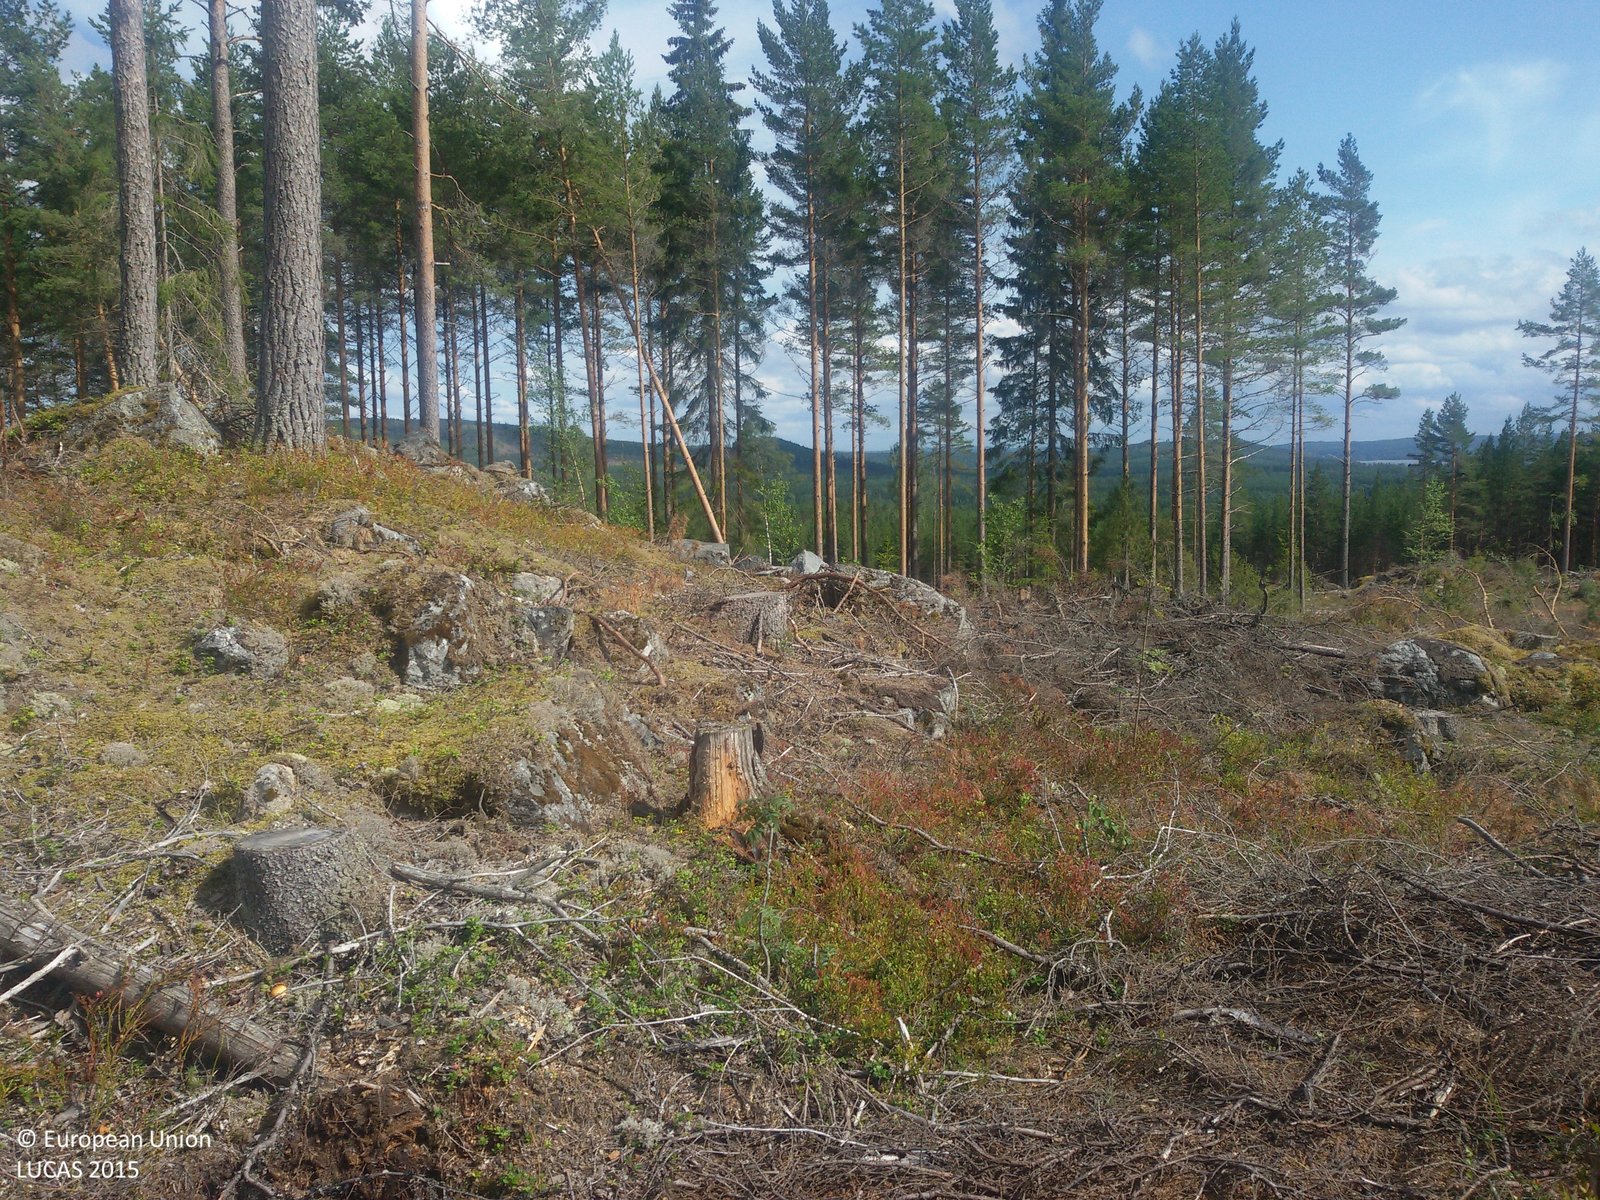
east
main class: Shrubland
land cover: Shrubland without tree cover
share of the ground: > 75 %
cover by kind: shrubs 85 %
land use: Forestry
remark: Clear cut
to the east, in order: Shrubland without tree cover; Pine dominated coniferous woodland; Tracks; Shrubland without tree cover; Pine dominated coniferous woodland; Spruce dominated coniferous woodland; Ditches and canals; Spruce dominated coniferous woodland
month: July
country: SE
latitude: 60.4860
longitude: 16.0114
